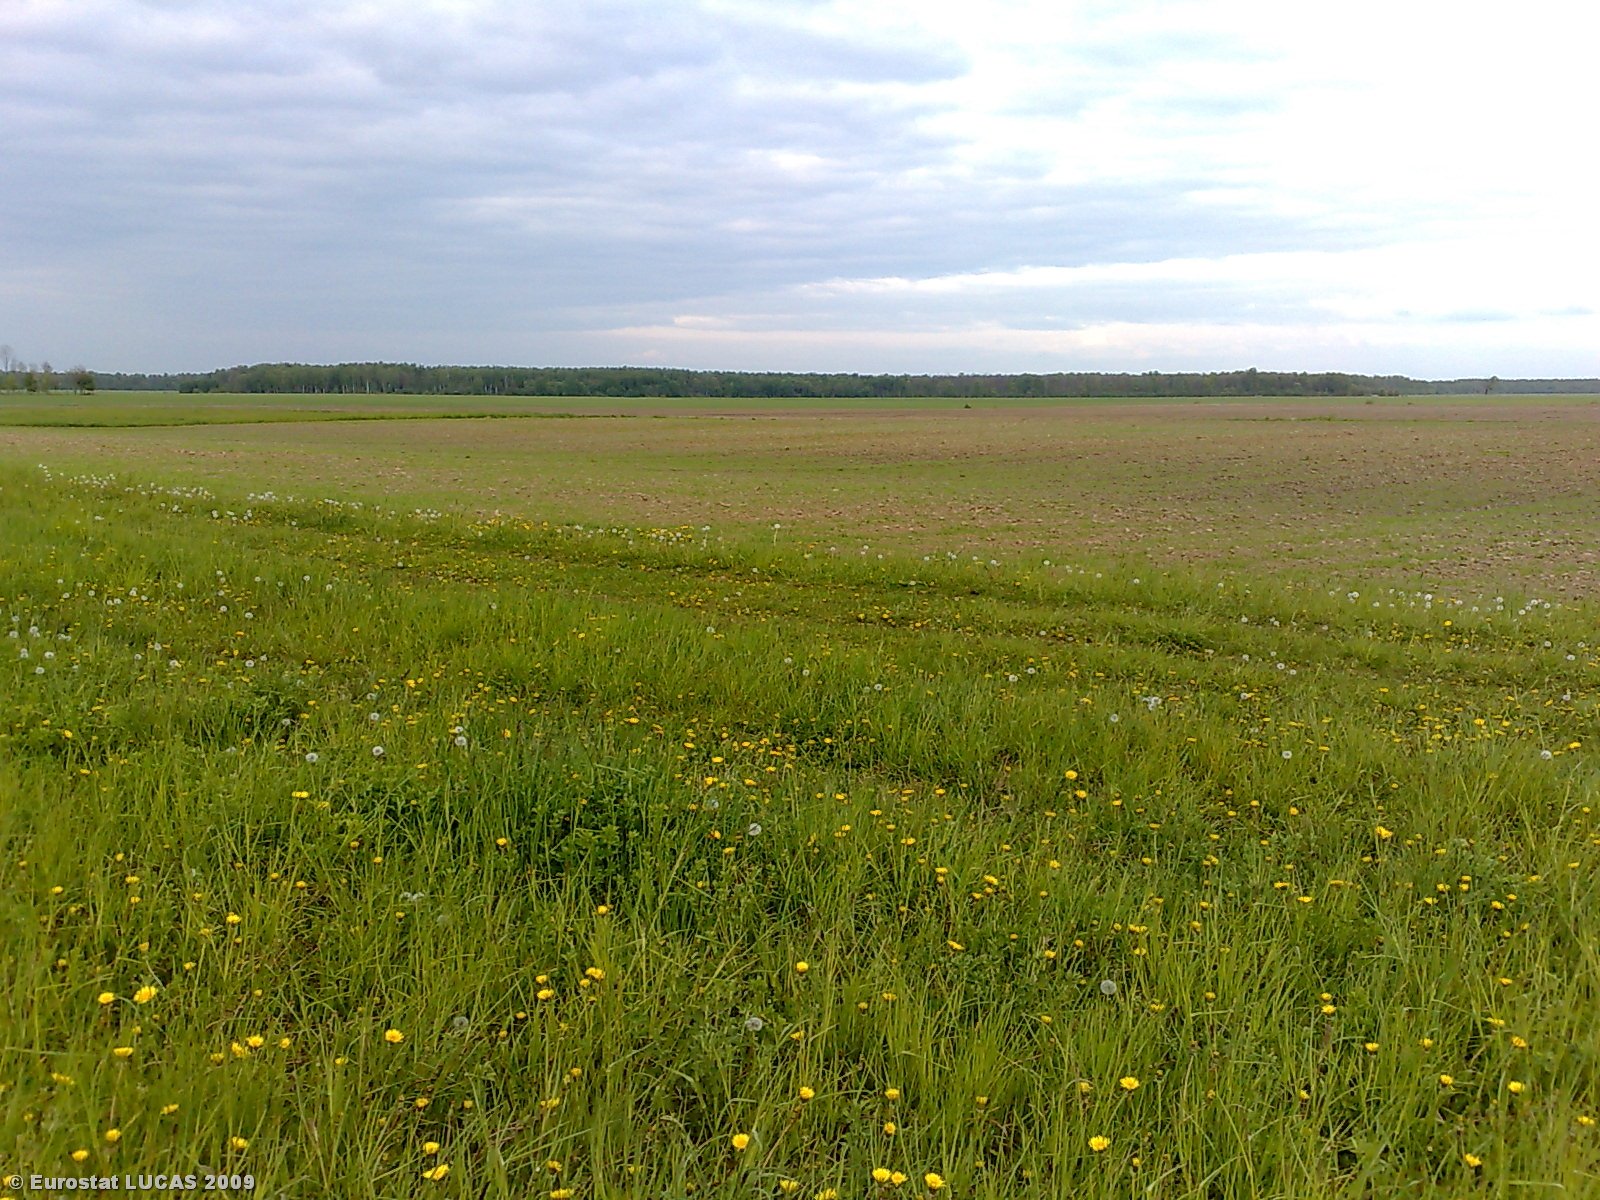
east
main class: Grassland
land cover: Grassland without tree/shrub cover
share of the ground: > 75 %
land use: Agriculture (excluding fallow land and kitchen gardens)
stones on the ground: < 10 %
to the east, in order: Grassland without tree/shrub cover; Barley; Bare land
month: May
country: LT
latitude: 55.6567
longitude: 23.9632
